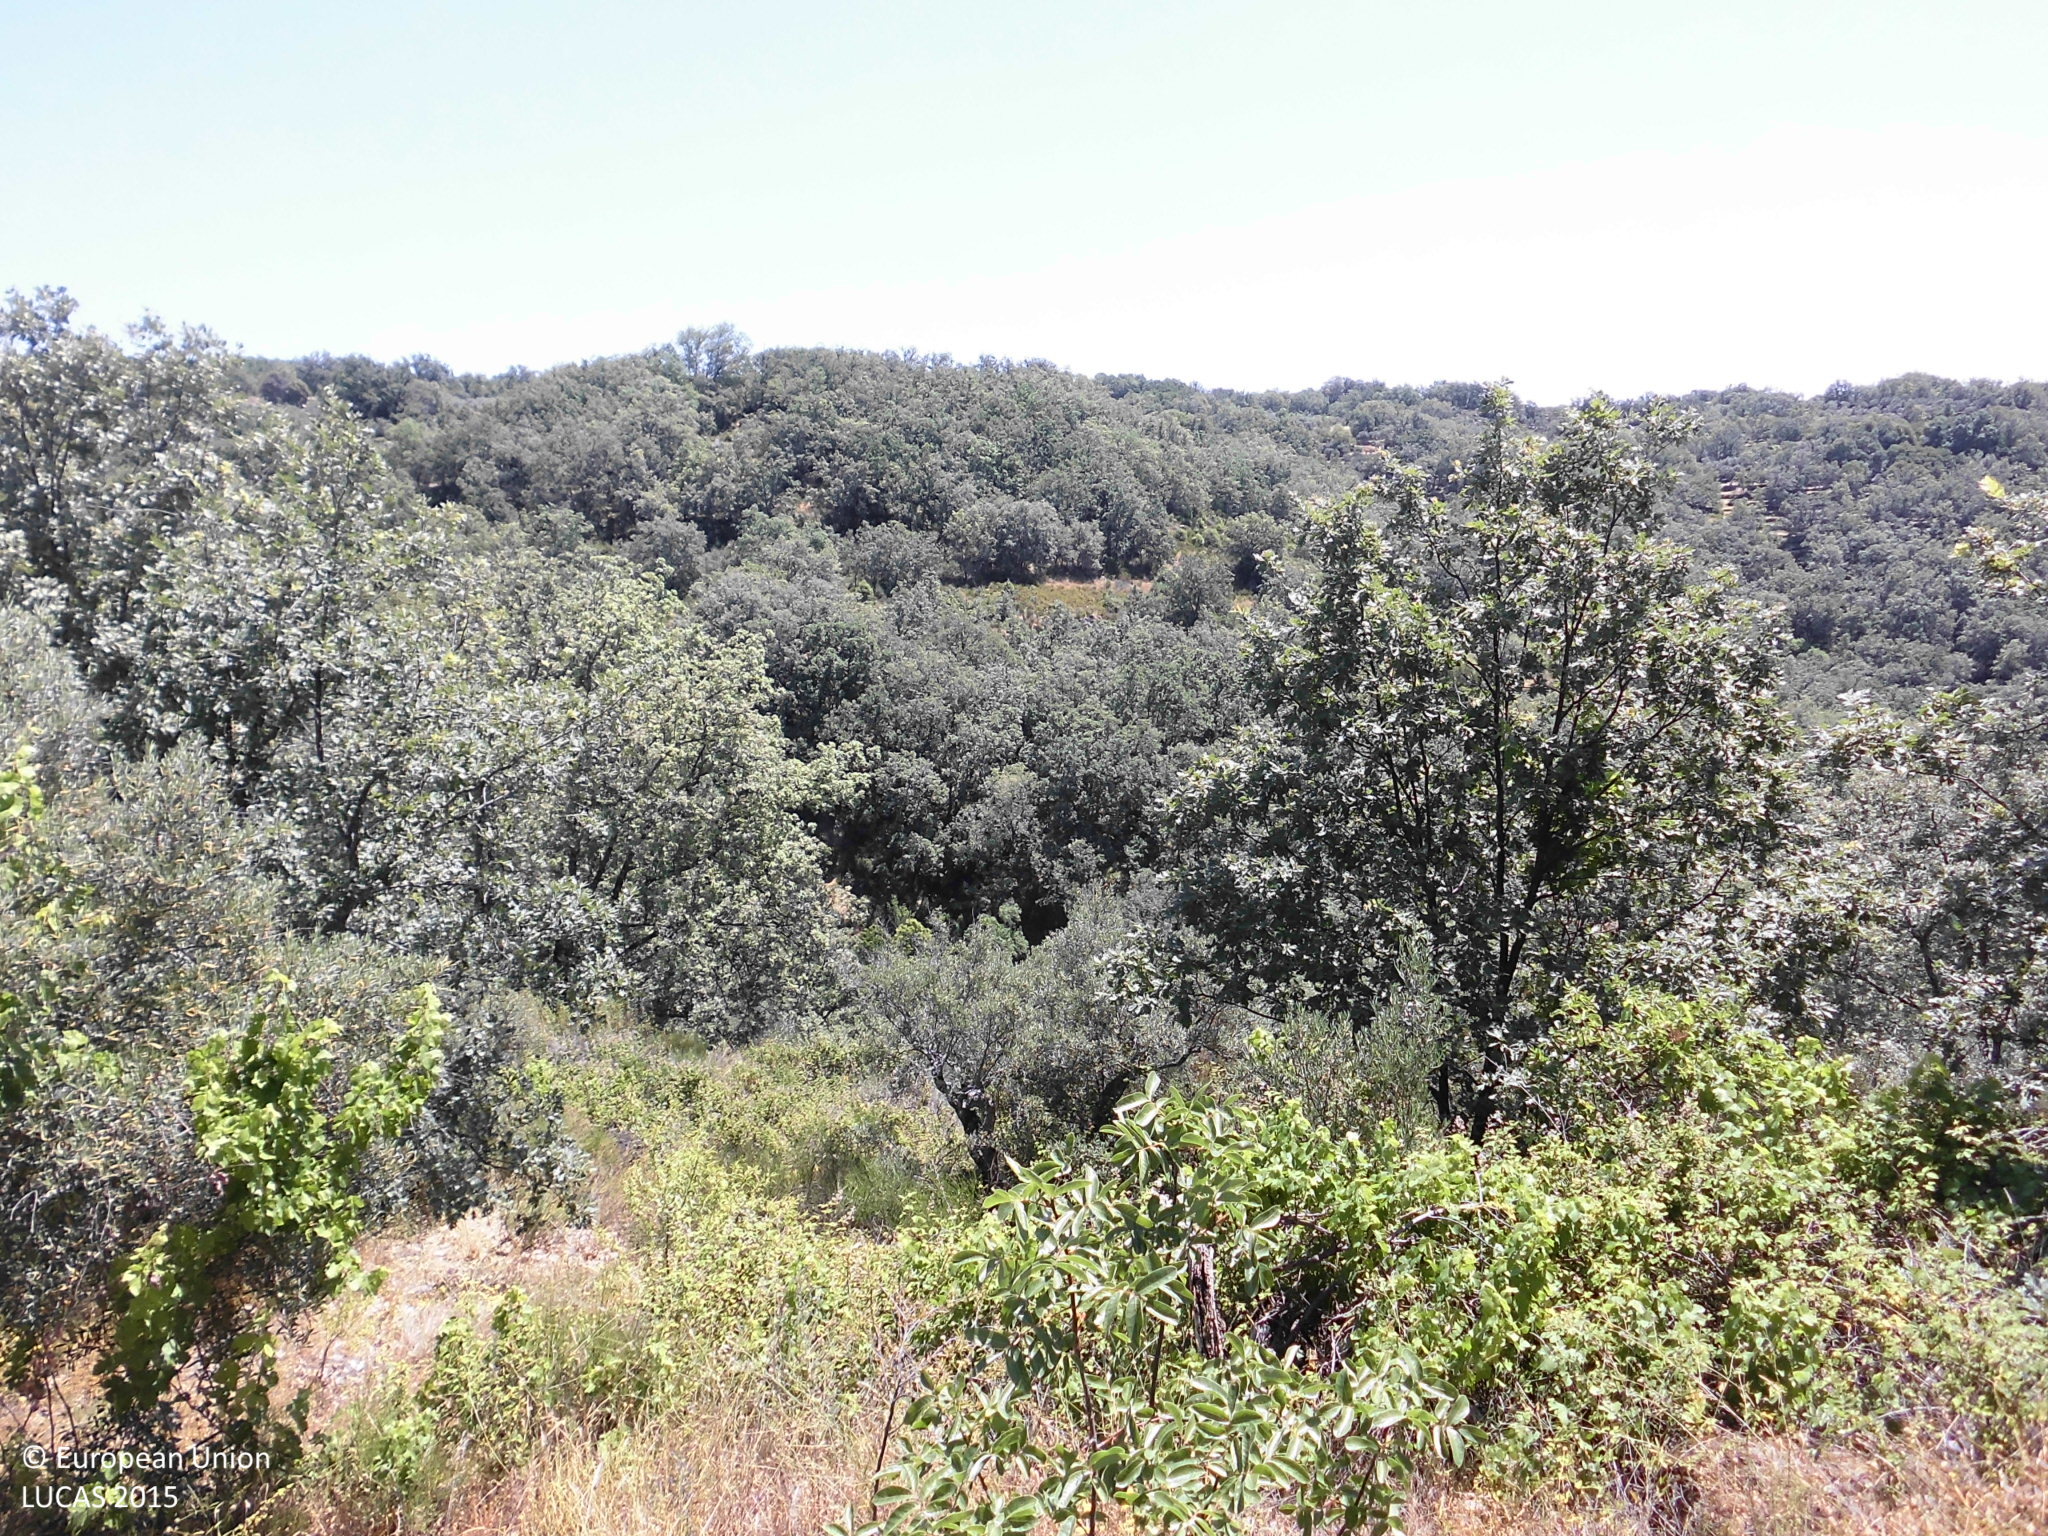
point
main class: Woodland
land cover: Broadleaved woodland
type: broadleaved evergreen forest
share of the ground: 25 - 50 %
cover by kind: herbaceous plants 55 %, broadleaved forest trees 35 %, shrubs 10 %
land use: Forestry
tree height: > 5 m
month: June
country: ES
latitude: 40.1059
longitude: -5.5358
